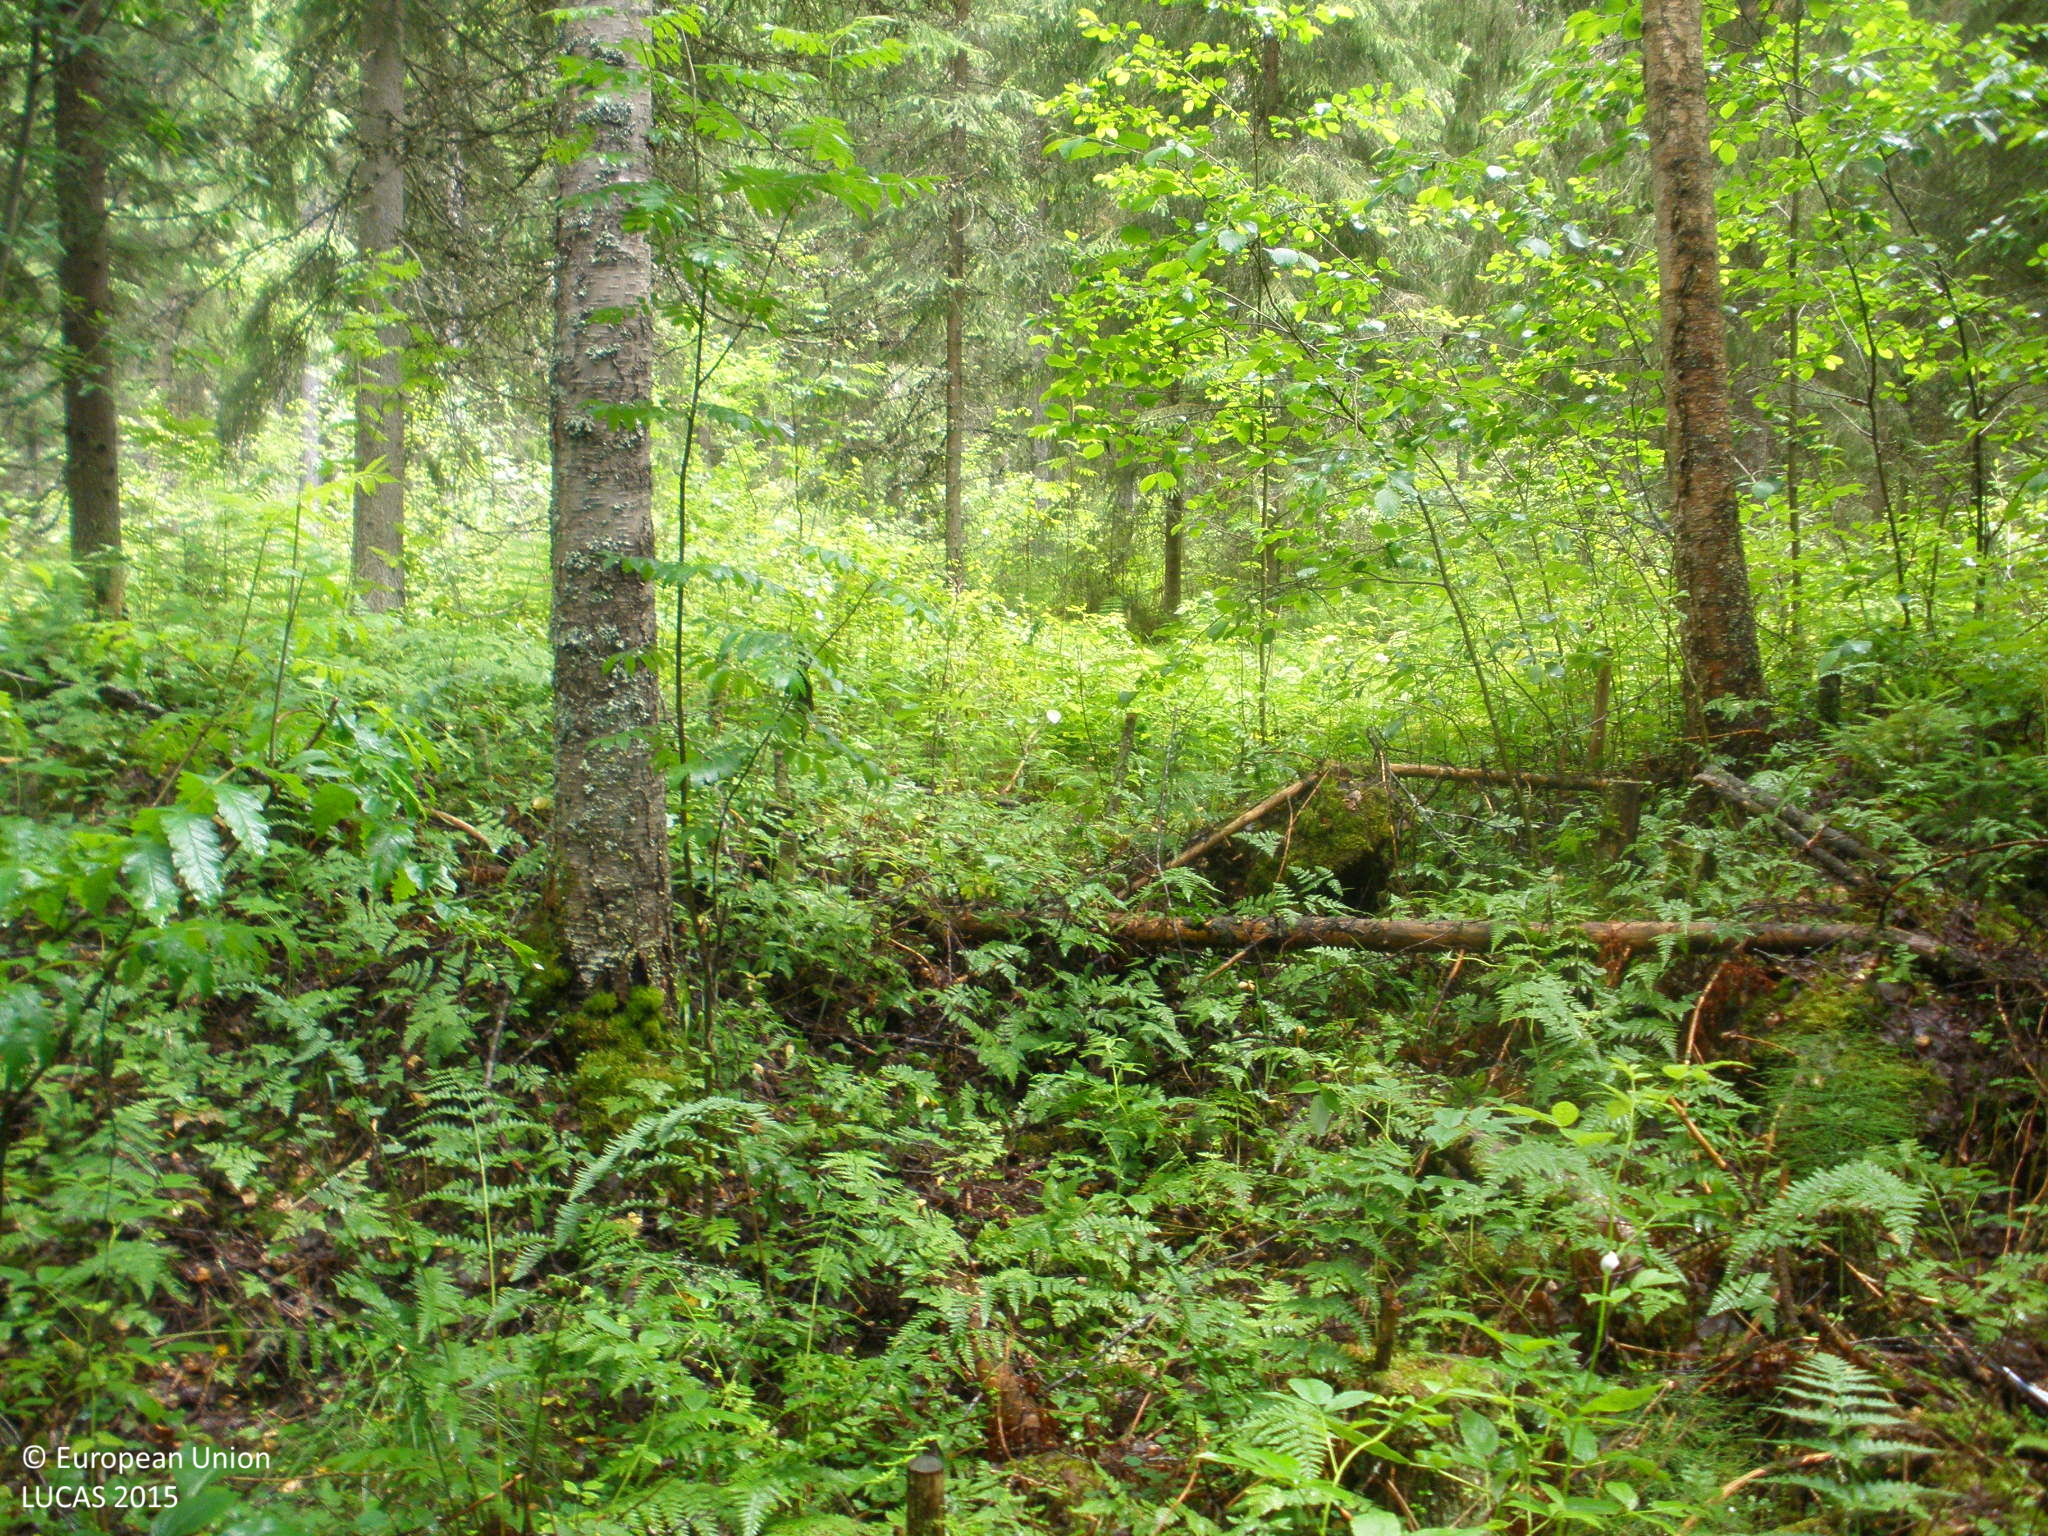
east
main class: Woodland
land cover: Spruce dominated mixed woodland
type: boreal forest
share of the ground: > 75 %
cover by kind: coniferous forest trees 40 %, broadleaved forest trees 40 %, herbaceous plants 10 %, lichens and mosses 10 %
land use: Forestry
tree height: > 5 m
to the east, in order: Ditches and canals; Spruce dominated mixed woodland; Ditches and canals; Spruce dominated mixed woodland; Pine dominated coniferous woodland; Spruce dominated mixed woodland; Pine dominated coniferous woodland; Tracks; Spruce dominated coniferous woodland
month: July
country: FI
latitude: 61.0191
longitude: 24.8940
